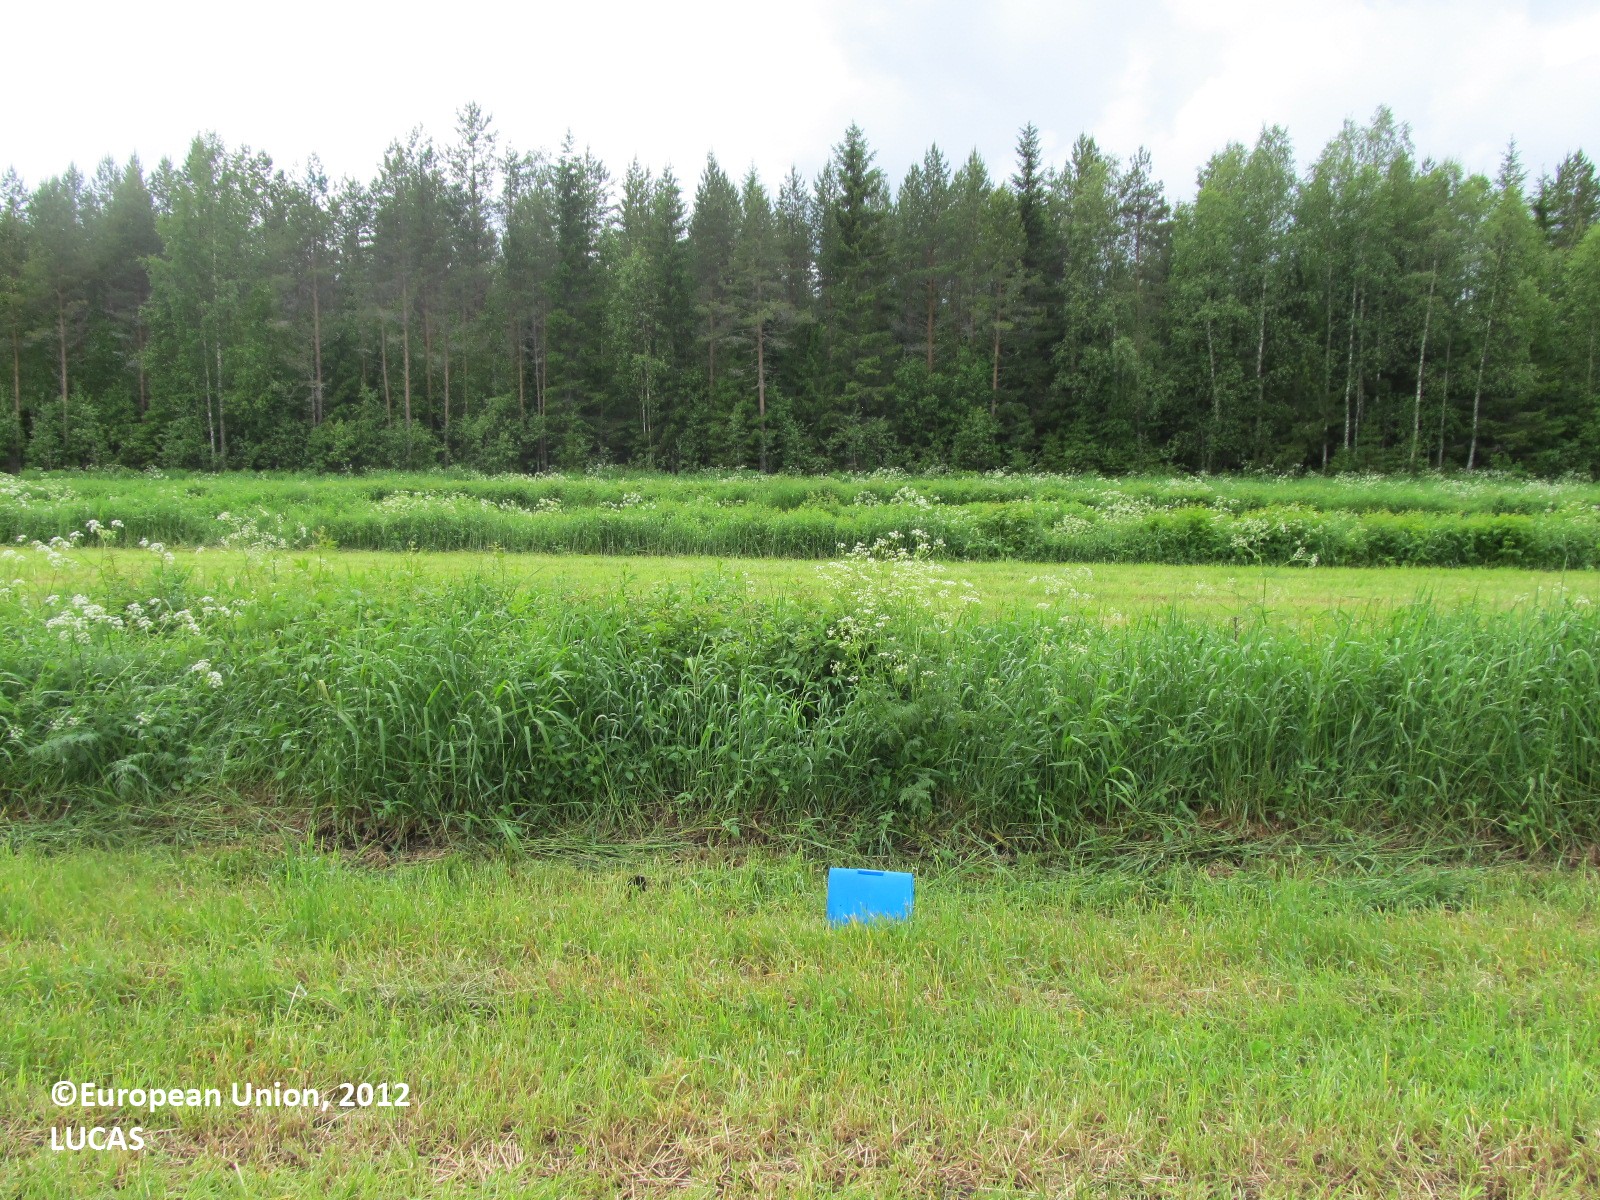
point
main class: Cropland
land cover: Temporary grasslands
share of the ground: 25 - 50 %
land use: Agriculture (excluding fallow land and kitchen gardens)
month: June
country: FI
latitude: 63.0695
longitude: 28.9530
